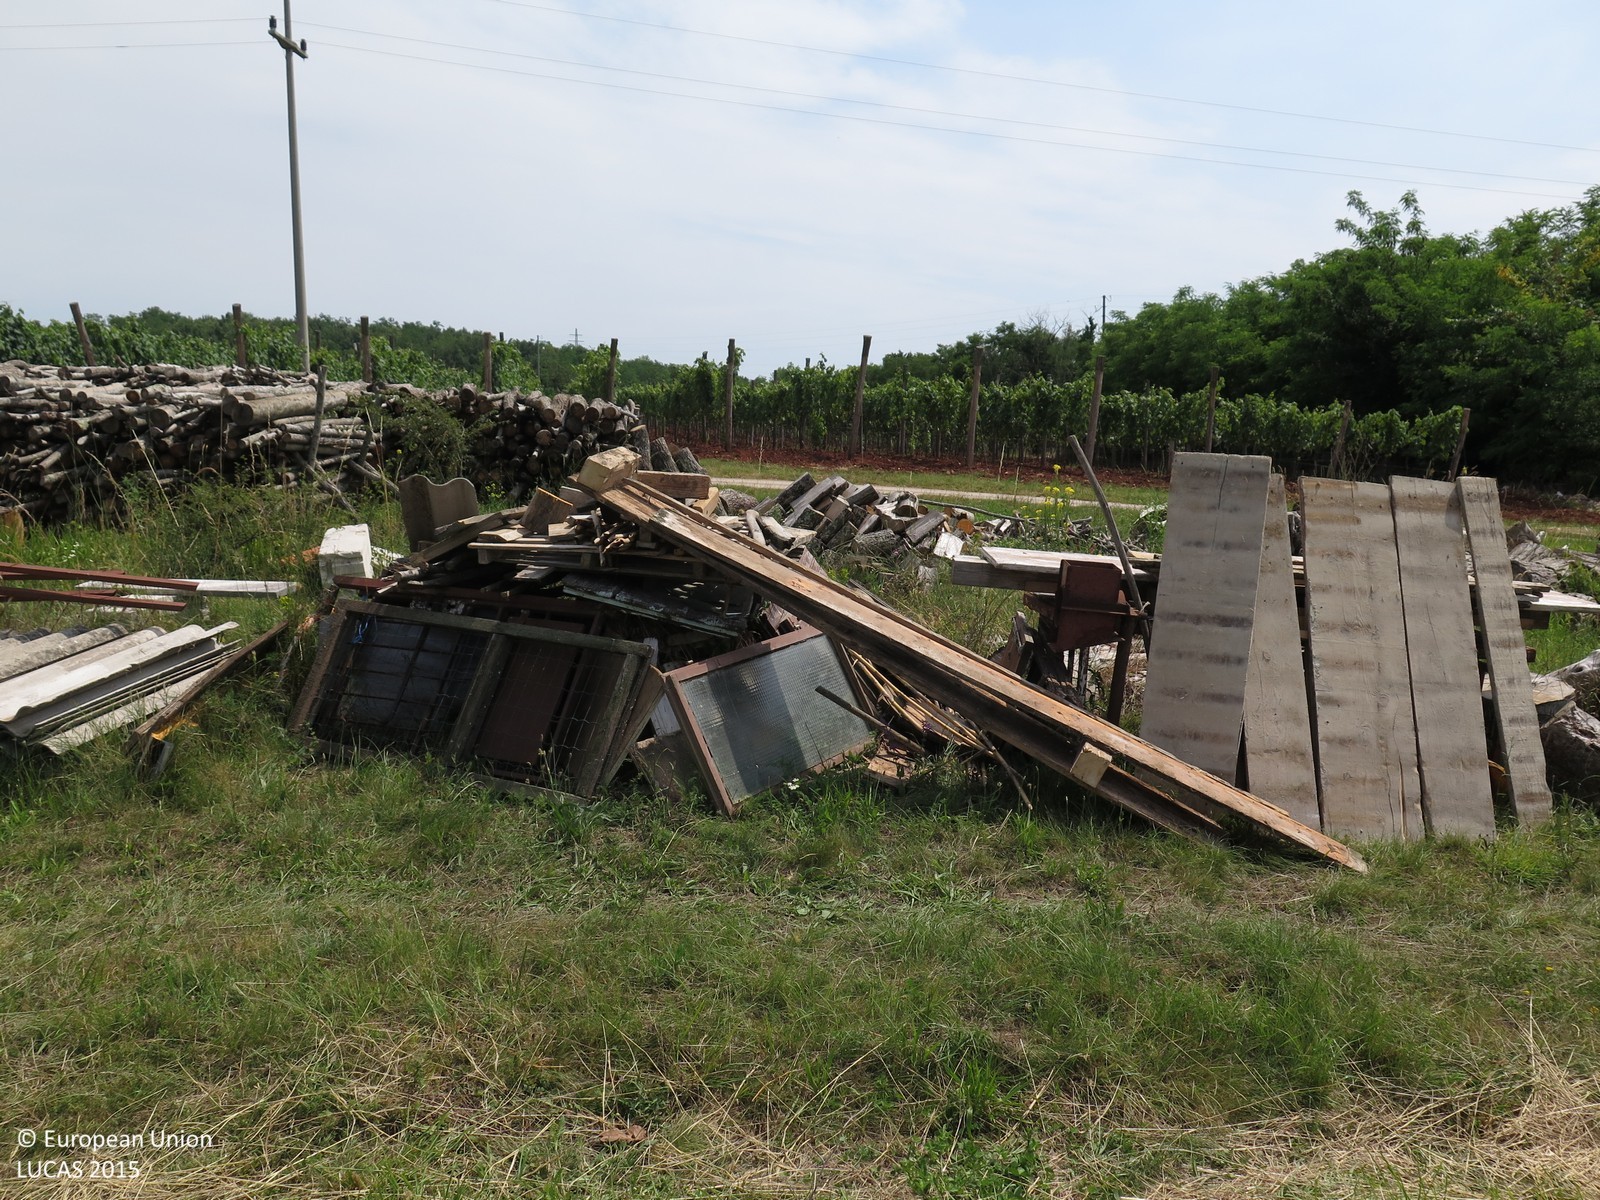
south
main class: Grassland
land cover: Grassland without tree/shrub cover
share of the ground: > 75 %
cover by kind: herbaceous plants 100 %
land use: Residential
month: June
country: HR
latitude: 45.2905
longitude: 13.8328
